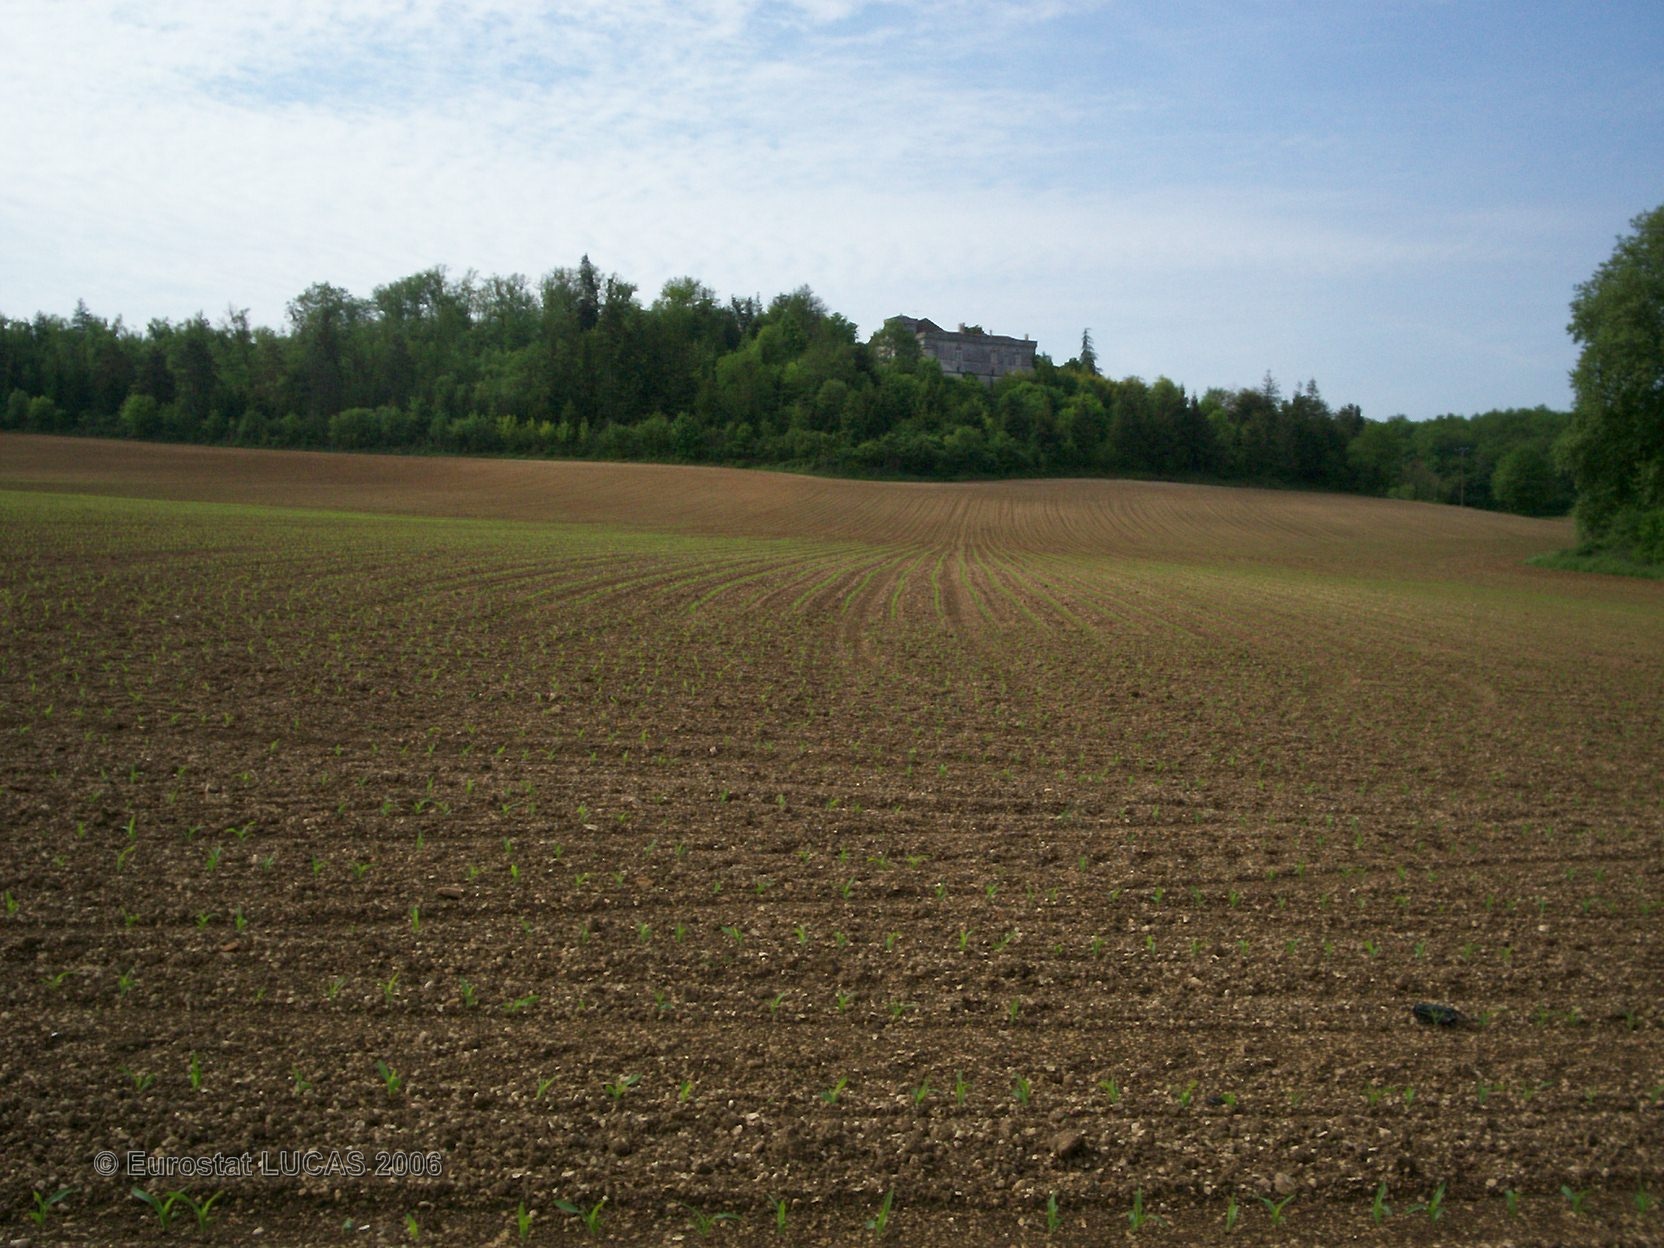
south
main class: Grassland
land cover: Grassland with sparse tree/shrub cover
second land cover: Nuts trees
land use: Agriculture (excluding fallow land and kitchen gardens)
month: May
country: FR
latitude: 45.4951
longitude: 0.5306
